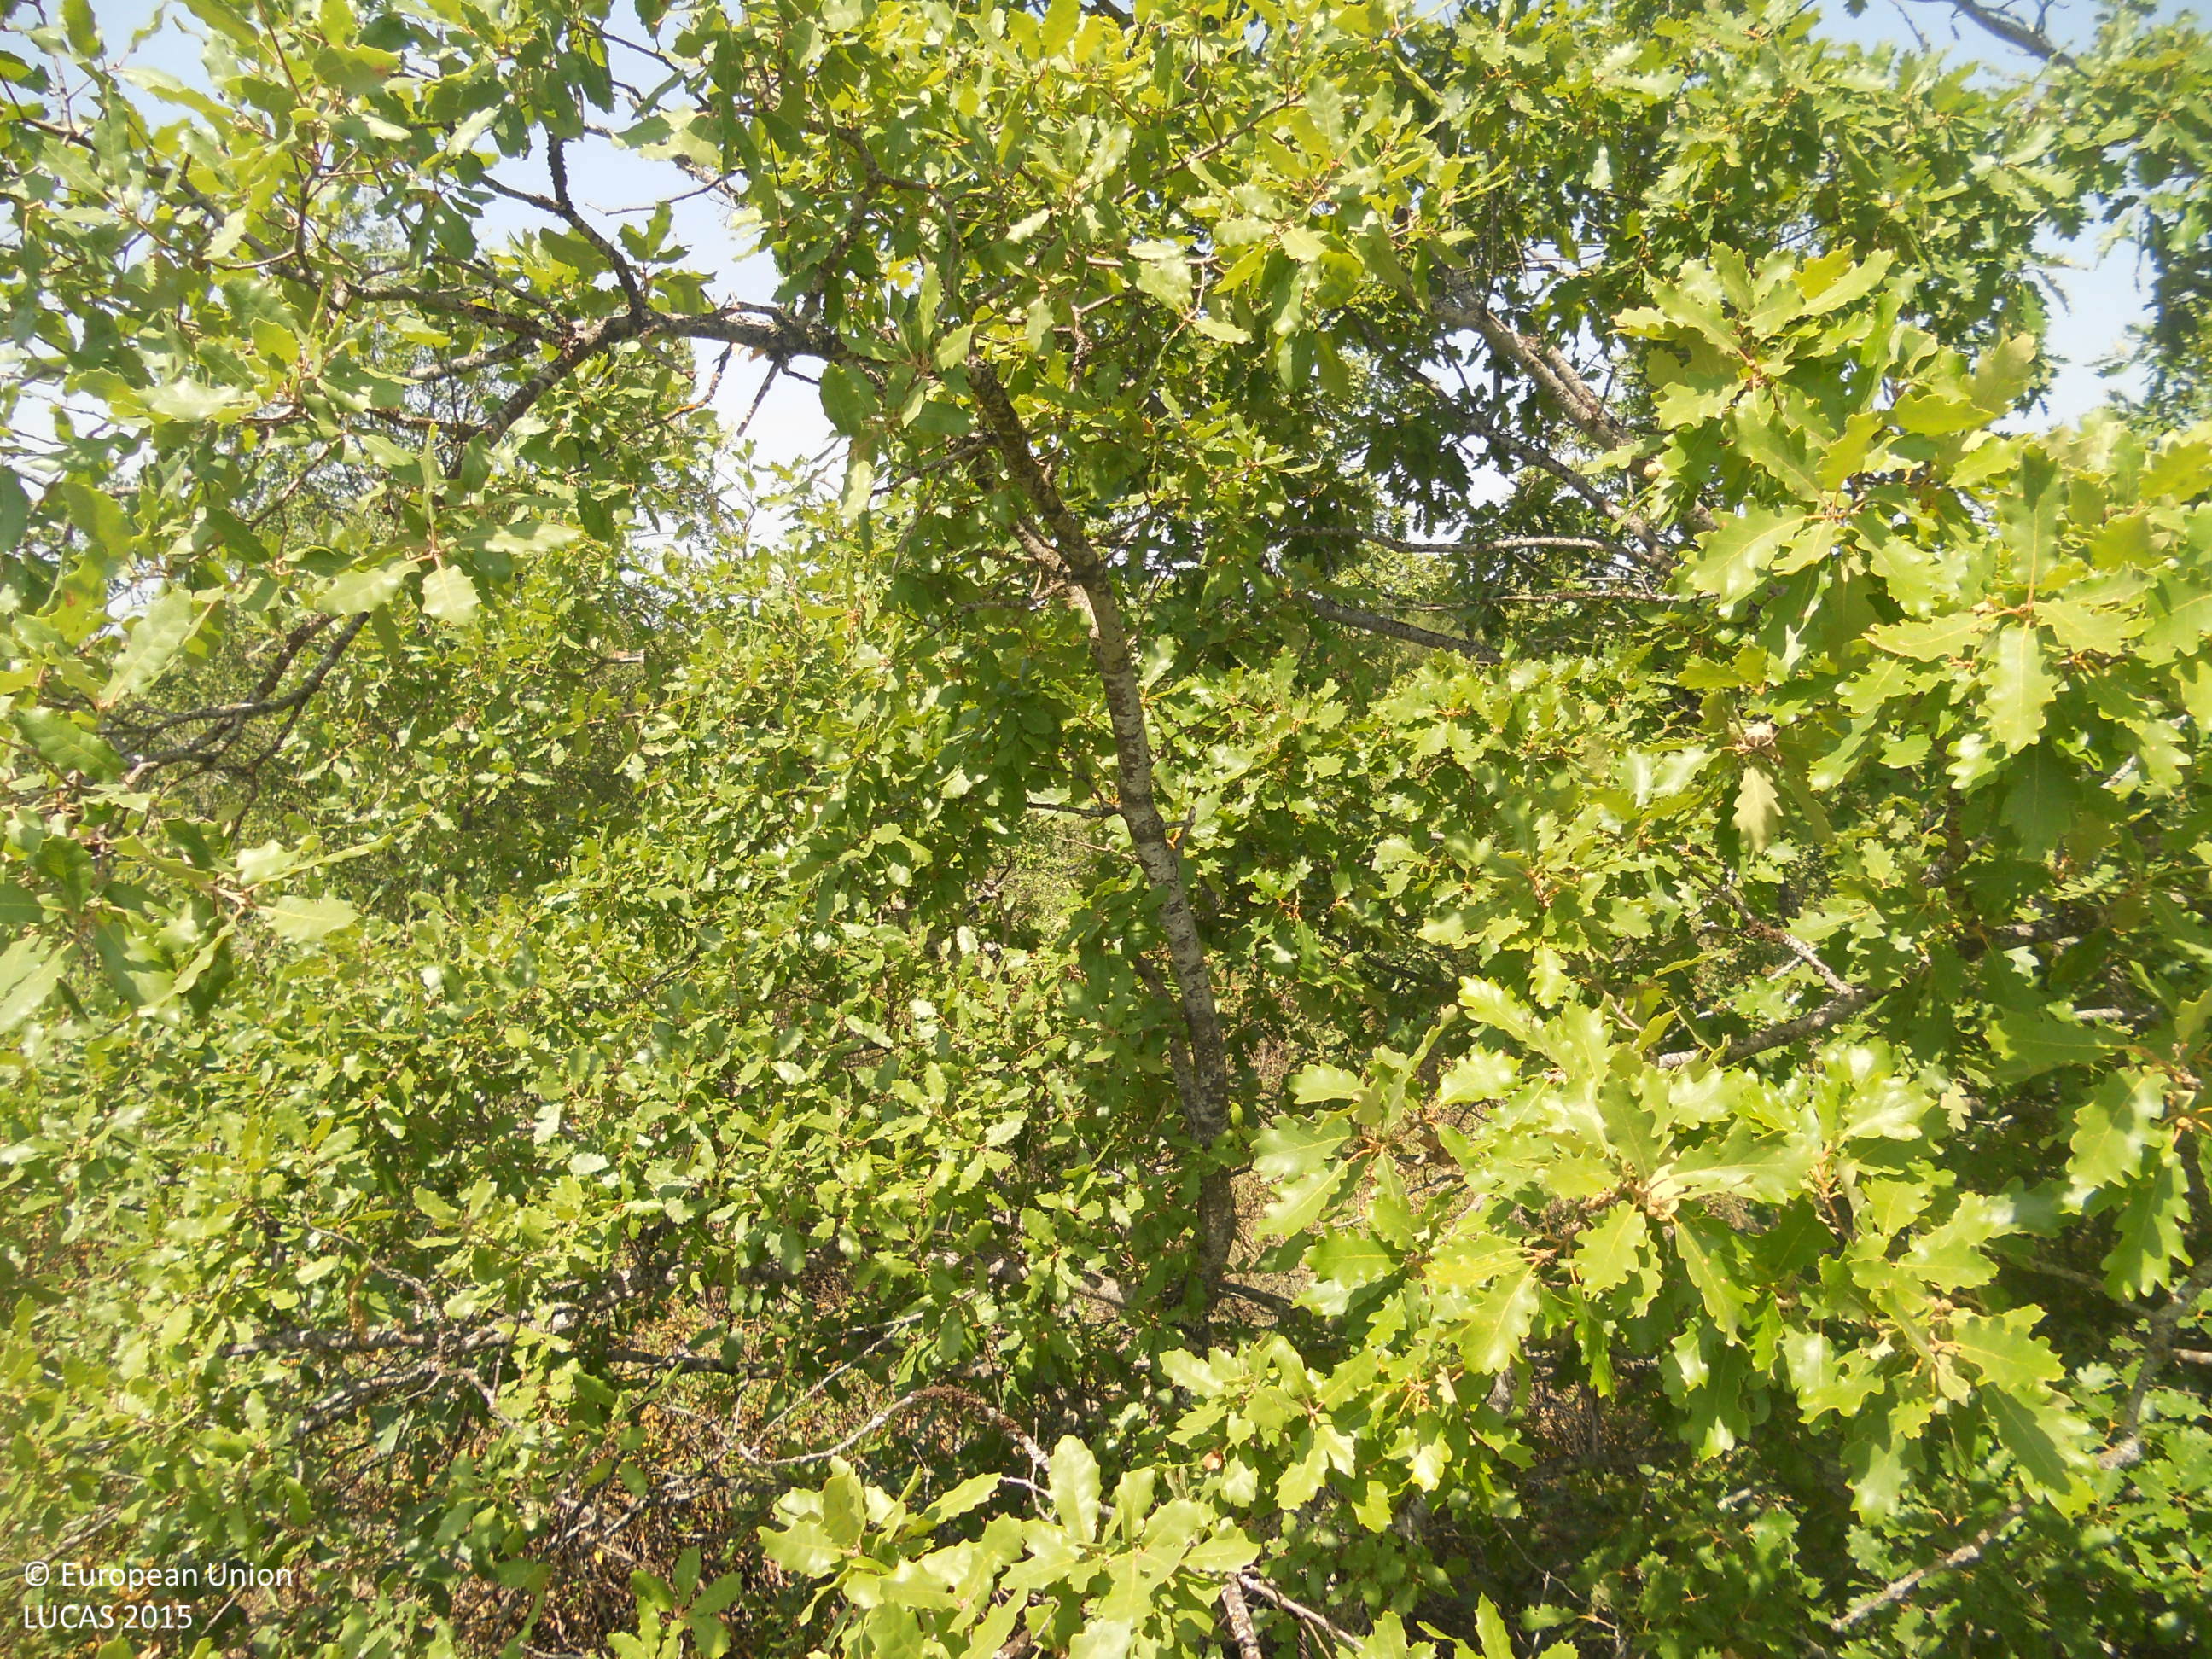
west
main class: Woodland
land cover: Broadleaved woodland
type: thermophilous deciduous forest
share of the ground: 25 - 50 %
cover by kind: broadleaved forest trees 40 %, shrubs 30 %, unconsolidated bare surface 20 %, herbaceous plants 10 %
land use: Semi-natural and natural areas not in use
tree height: < 5 m
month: July
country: ES
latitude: 42.6145
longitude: -5.3433
